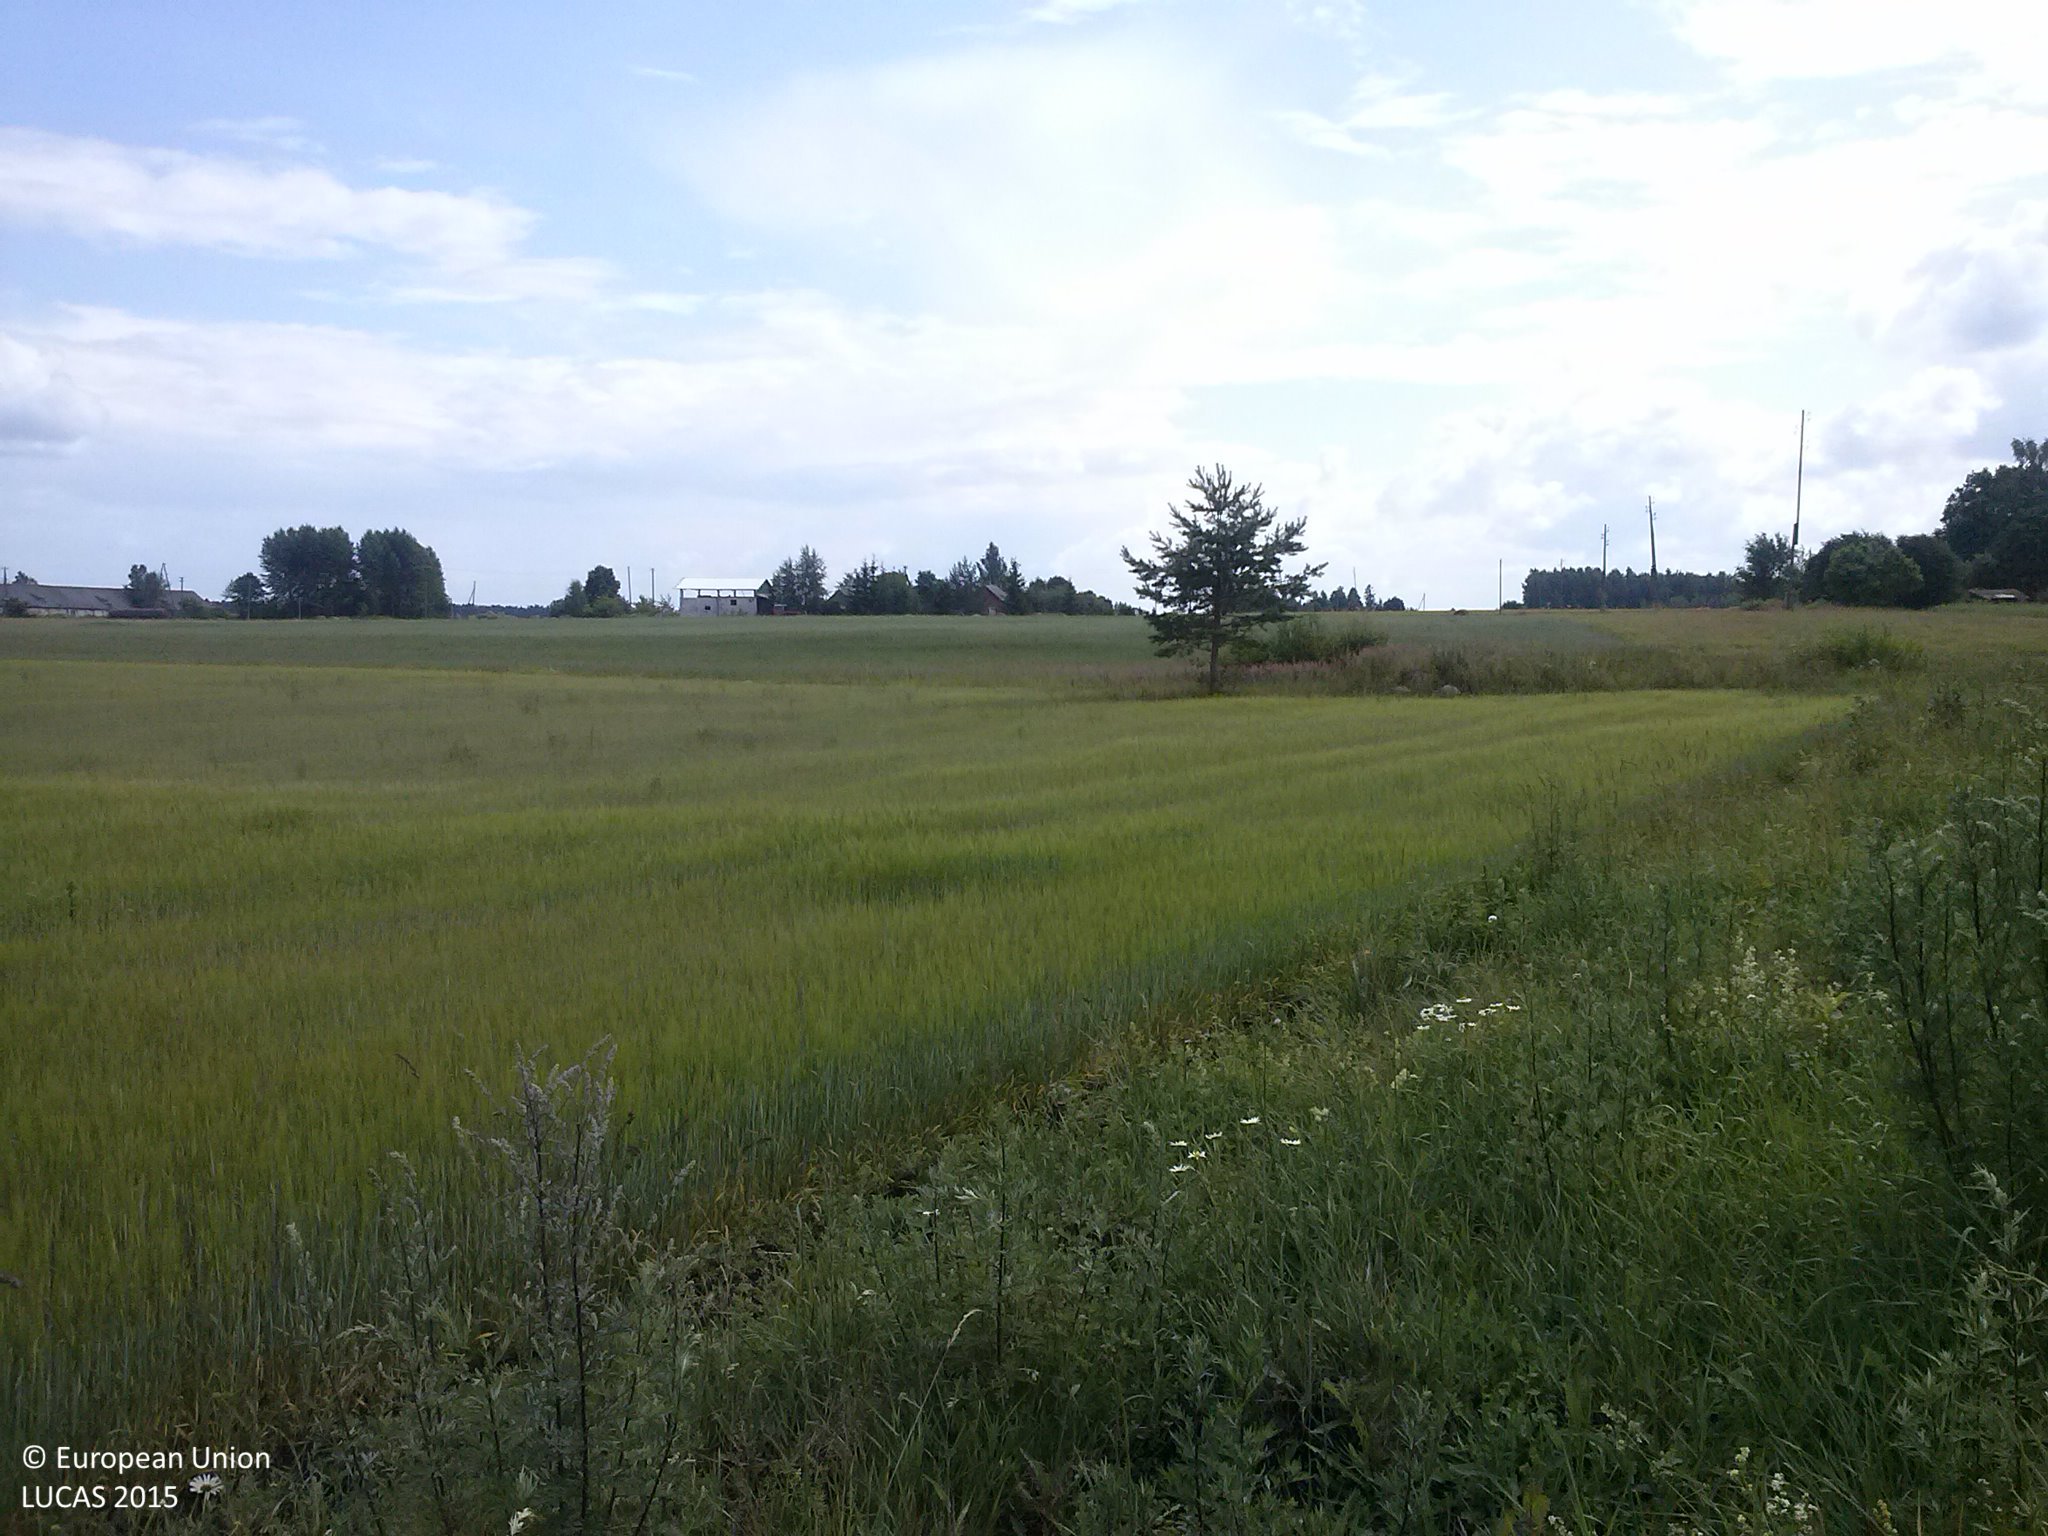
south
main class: Grassland
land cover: Spontaneously vegetated surfaces
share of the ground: > 75 %
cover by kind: herbaceous plants 100 %
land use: Fallow land
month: July
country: LV
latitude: 56.7826
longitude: 27.6129
